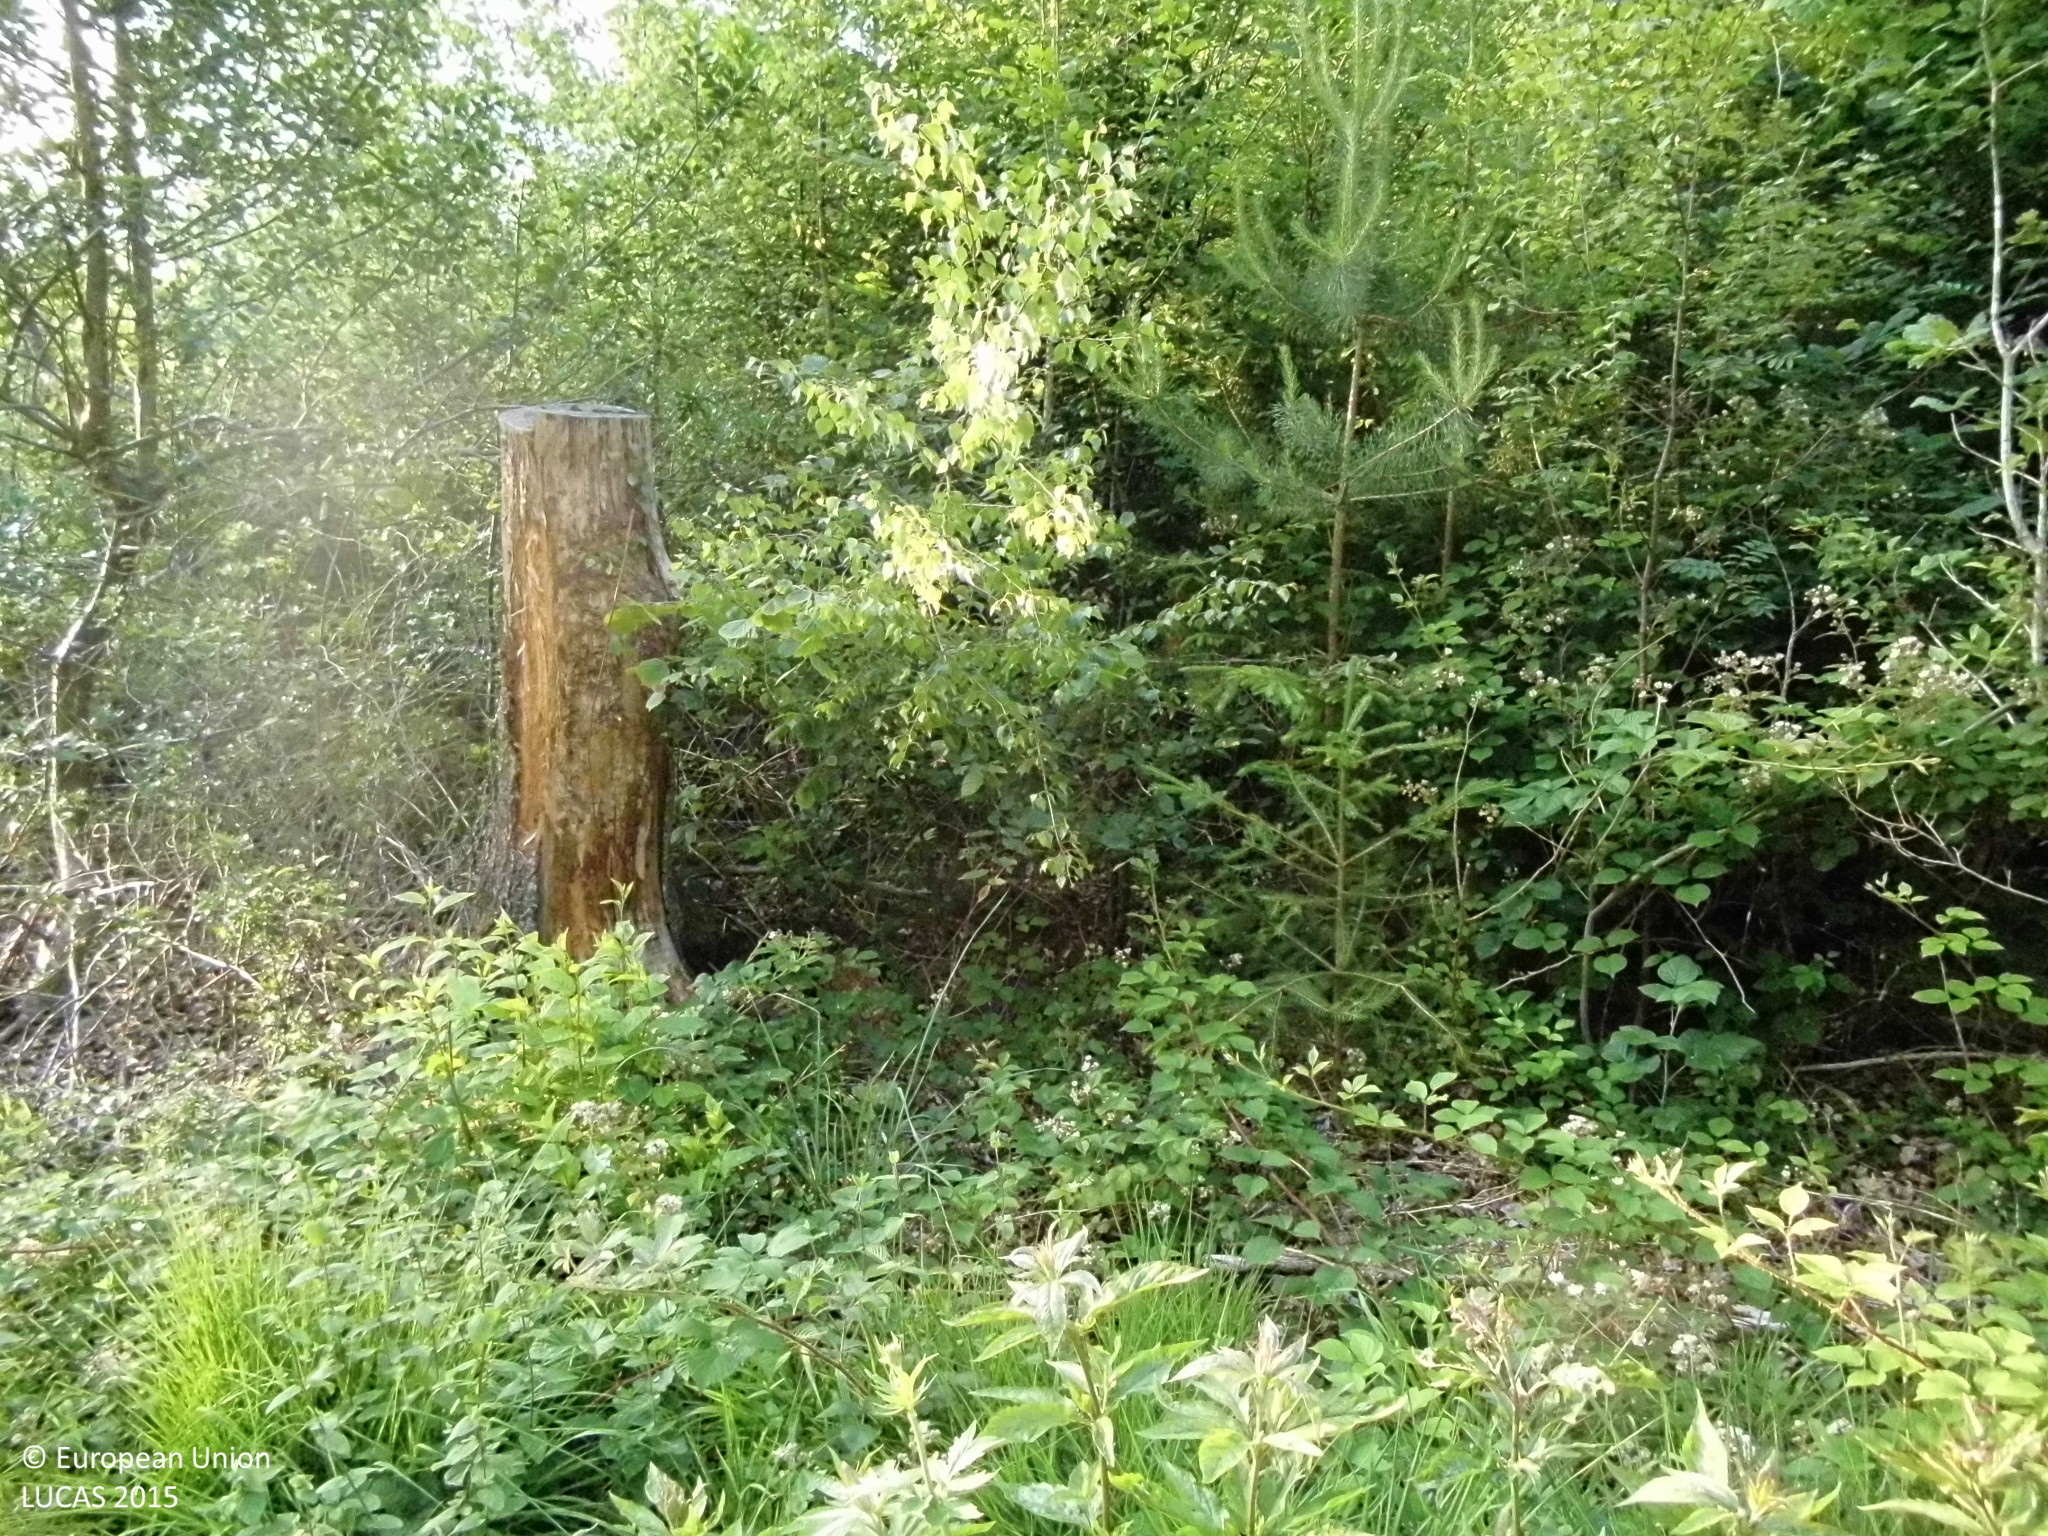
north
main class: Woodland
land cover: Broadleaved woodland
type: mesophytic deciduous forest
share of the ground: > 75 %
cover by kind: broadleaved forest trees 100 %
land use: Forestry
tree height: > 5 m
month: June
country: DE
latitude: 50.8222
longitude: 7.4876
